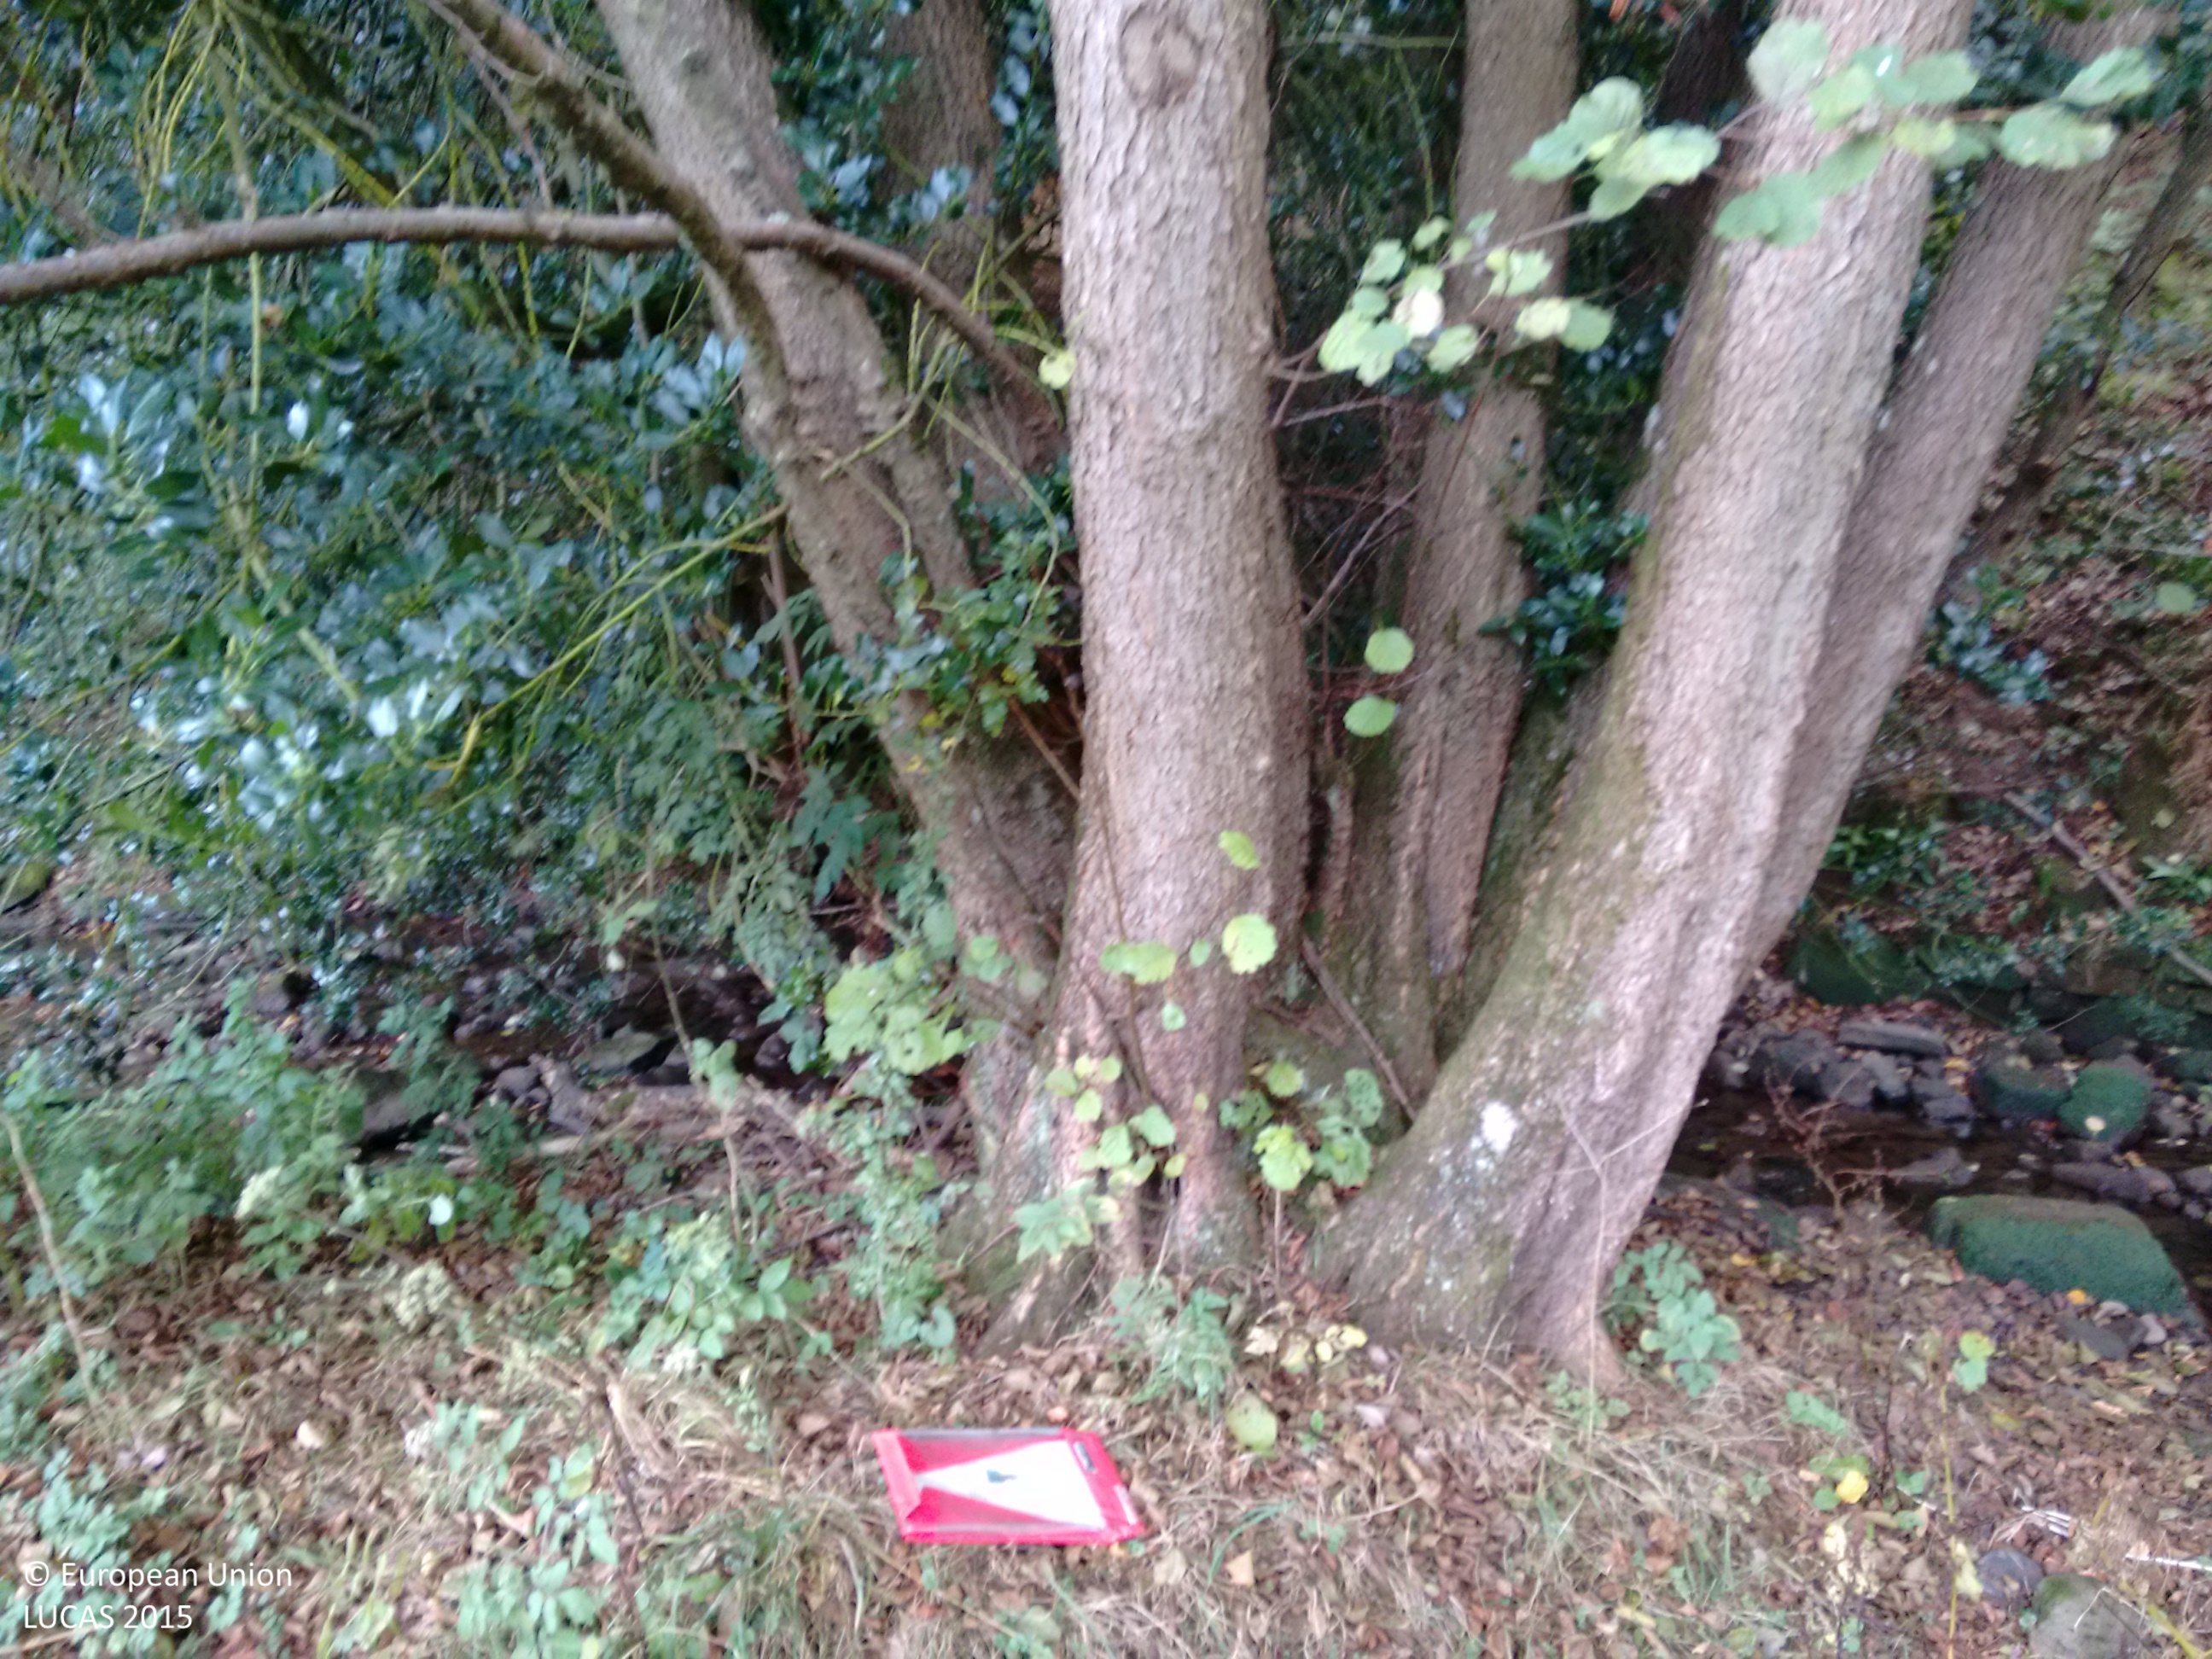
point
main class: Woodland
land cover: Broadleaved woodland
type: mesophytic deciduous forest
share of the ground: > 75 %
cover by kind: broadleaved forest trees 80 %, shrubs 10 %, herbaceous plants 10 %
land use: Semi-natural and natural areas not in use
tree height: > 5 m
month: October
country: GB
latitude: 51.7688
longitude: -2.6620
